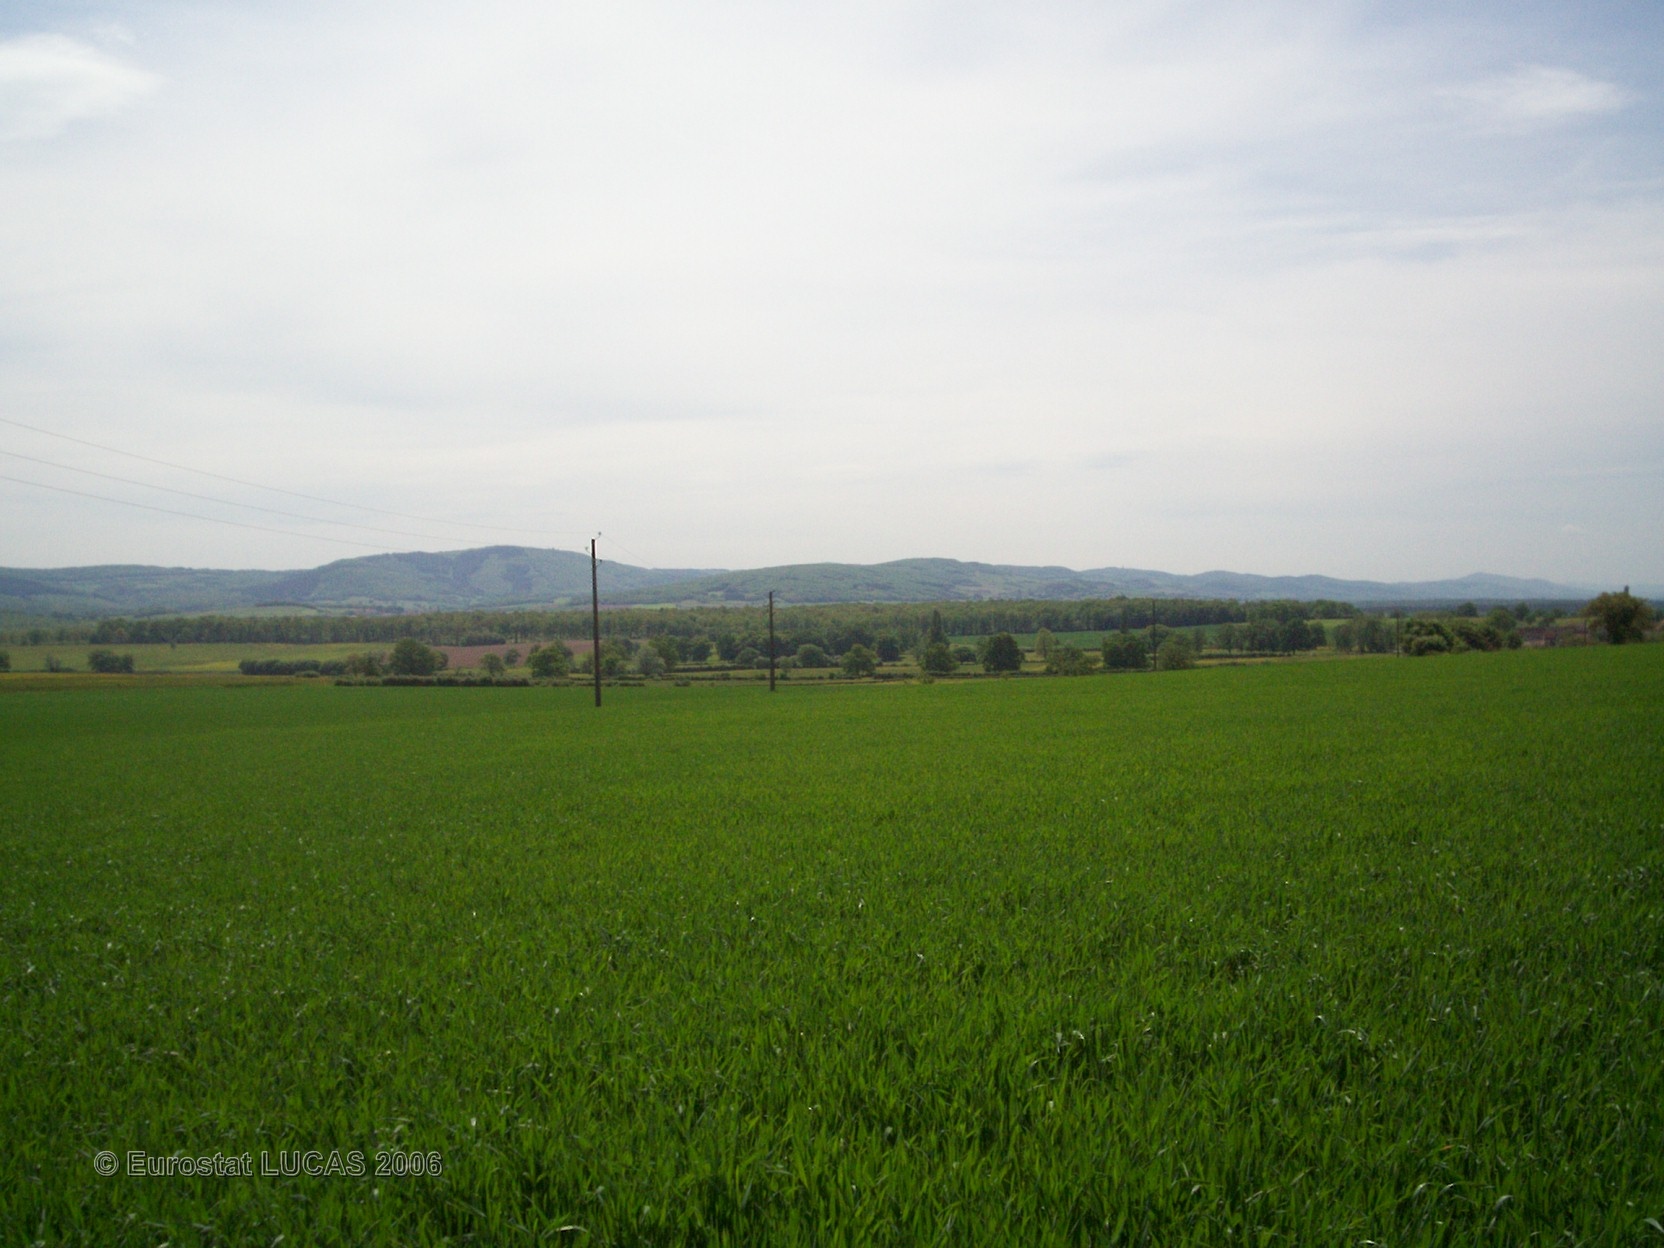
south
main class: Cropland
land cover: Common wheat
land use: Agriculture (excluding fallow land and kitchen gardens)
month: May
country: FR
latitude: 46.5636
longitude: 4.7181
